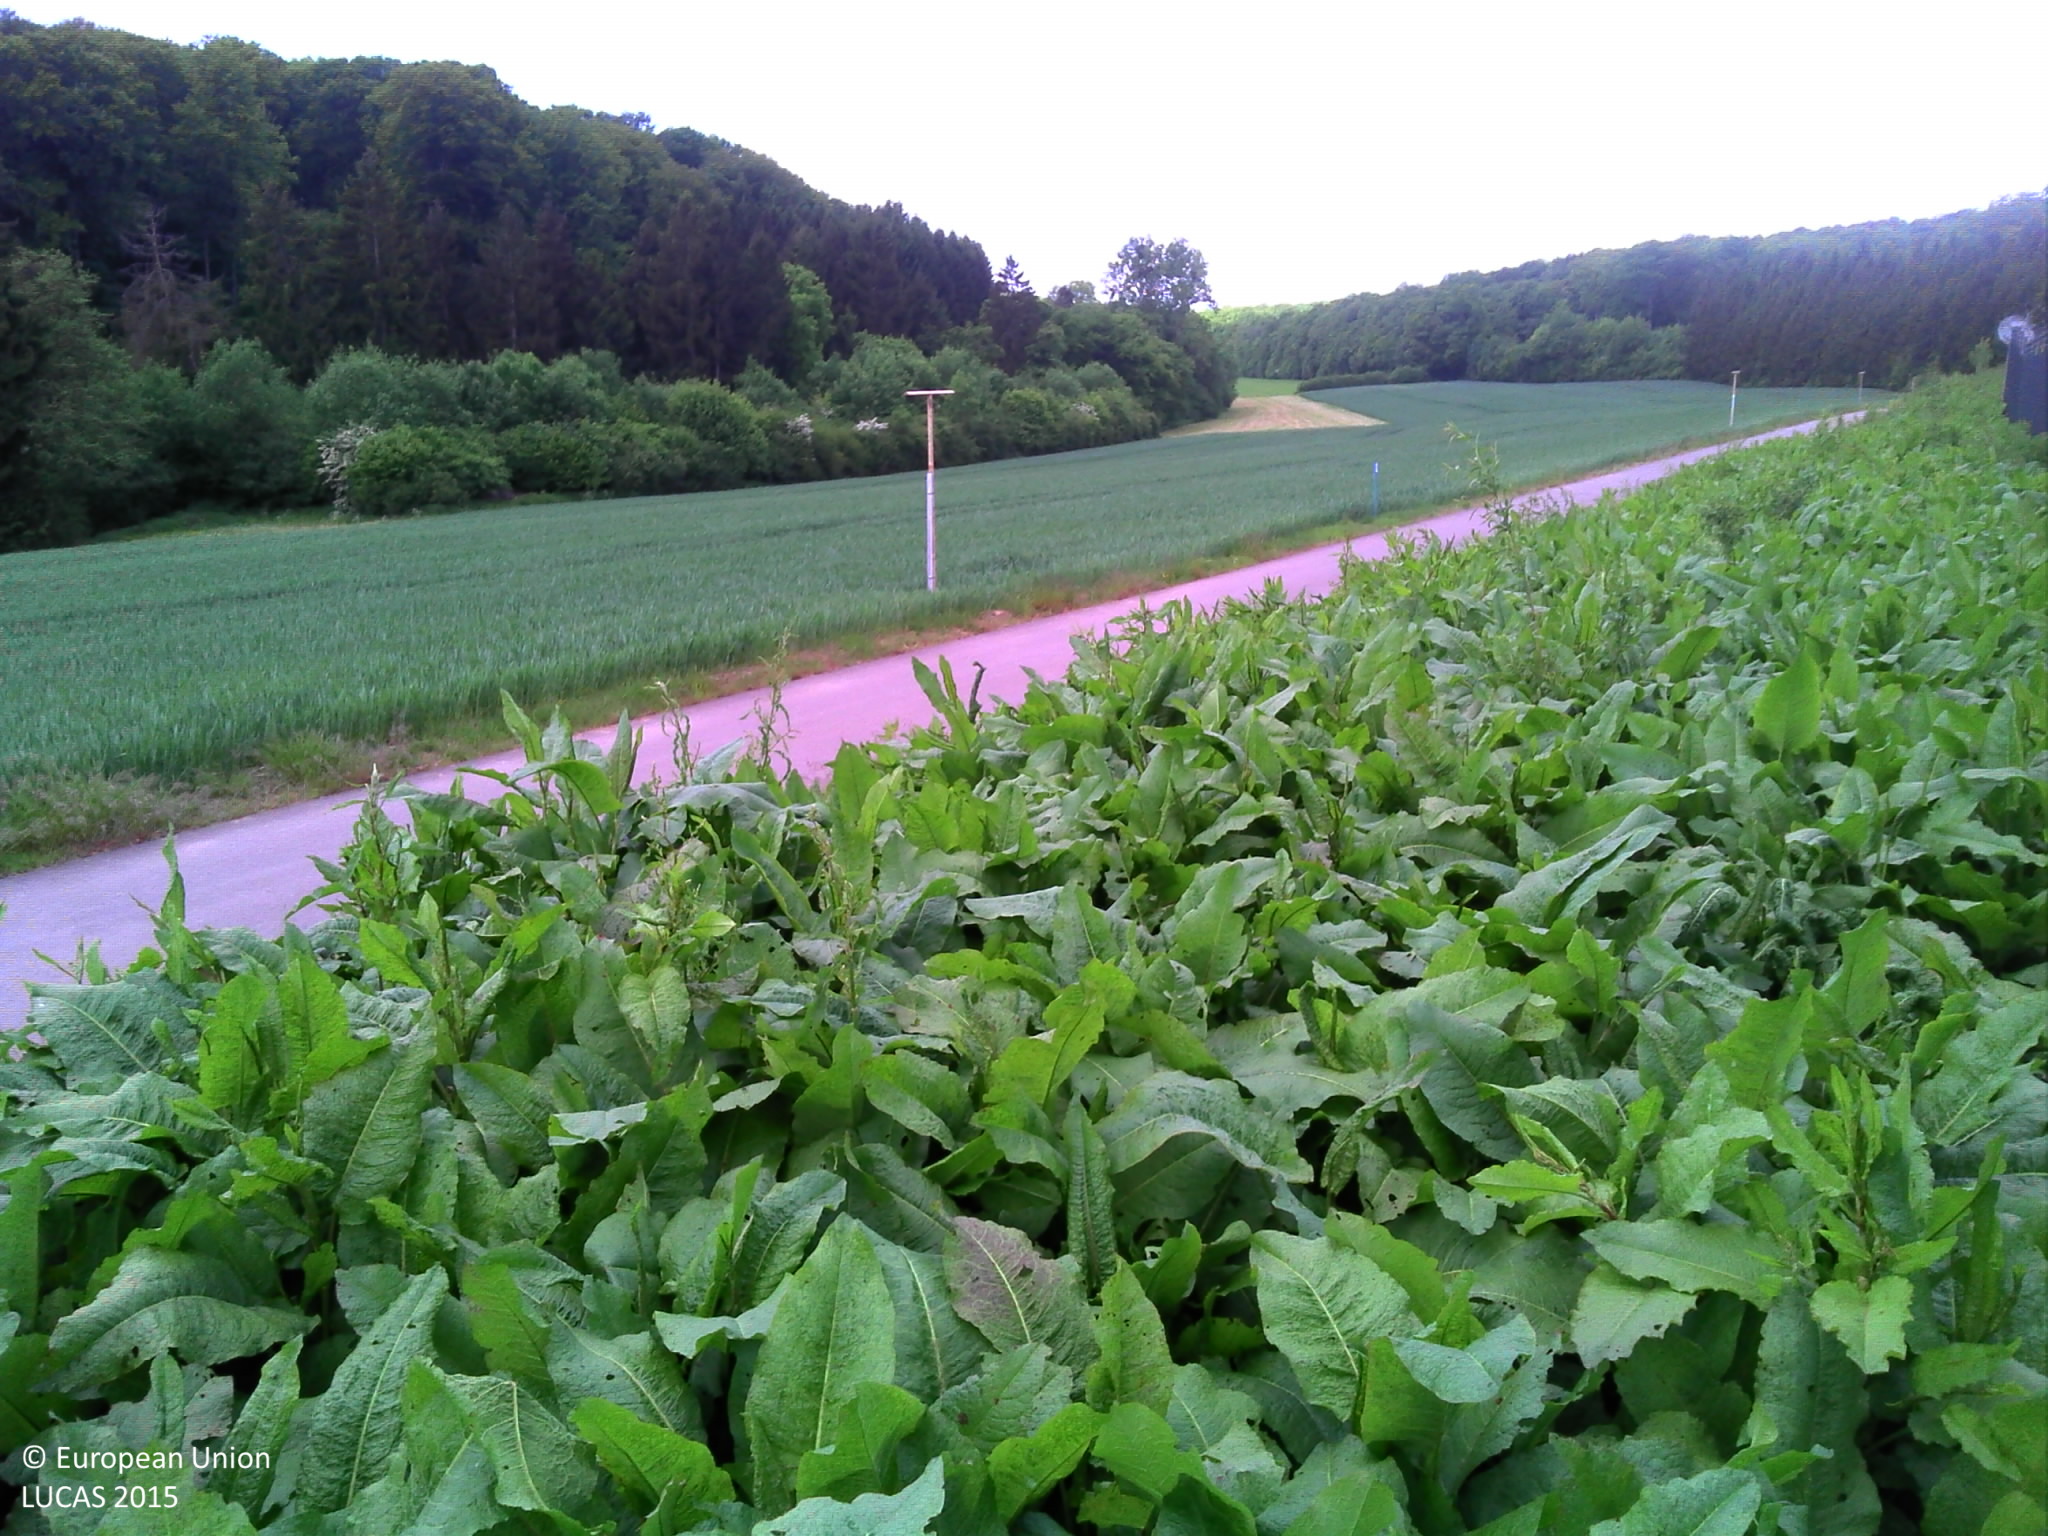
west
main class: Grassland
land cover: Spontaneously vegetated surfaces
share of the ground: > 75 %
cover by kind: herbaceous plants 100 %
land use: Semi-natural and natural areas not in use
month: May
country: LU
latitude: 49.6930
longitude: 6.3260
